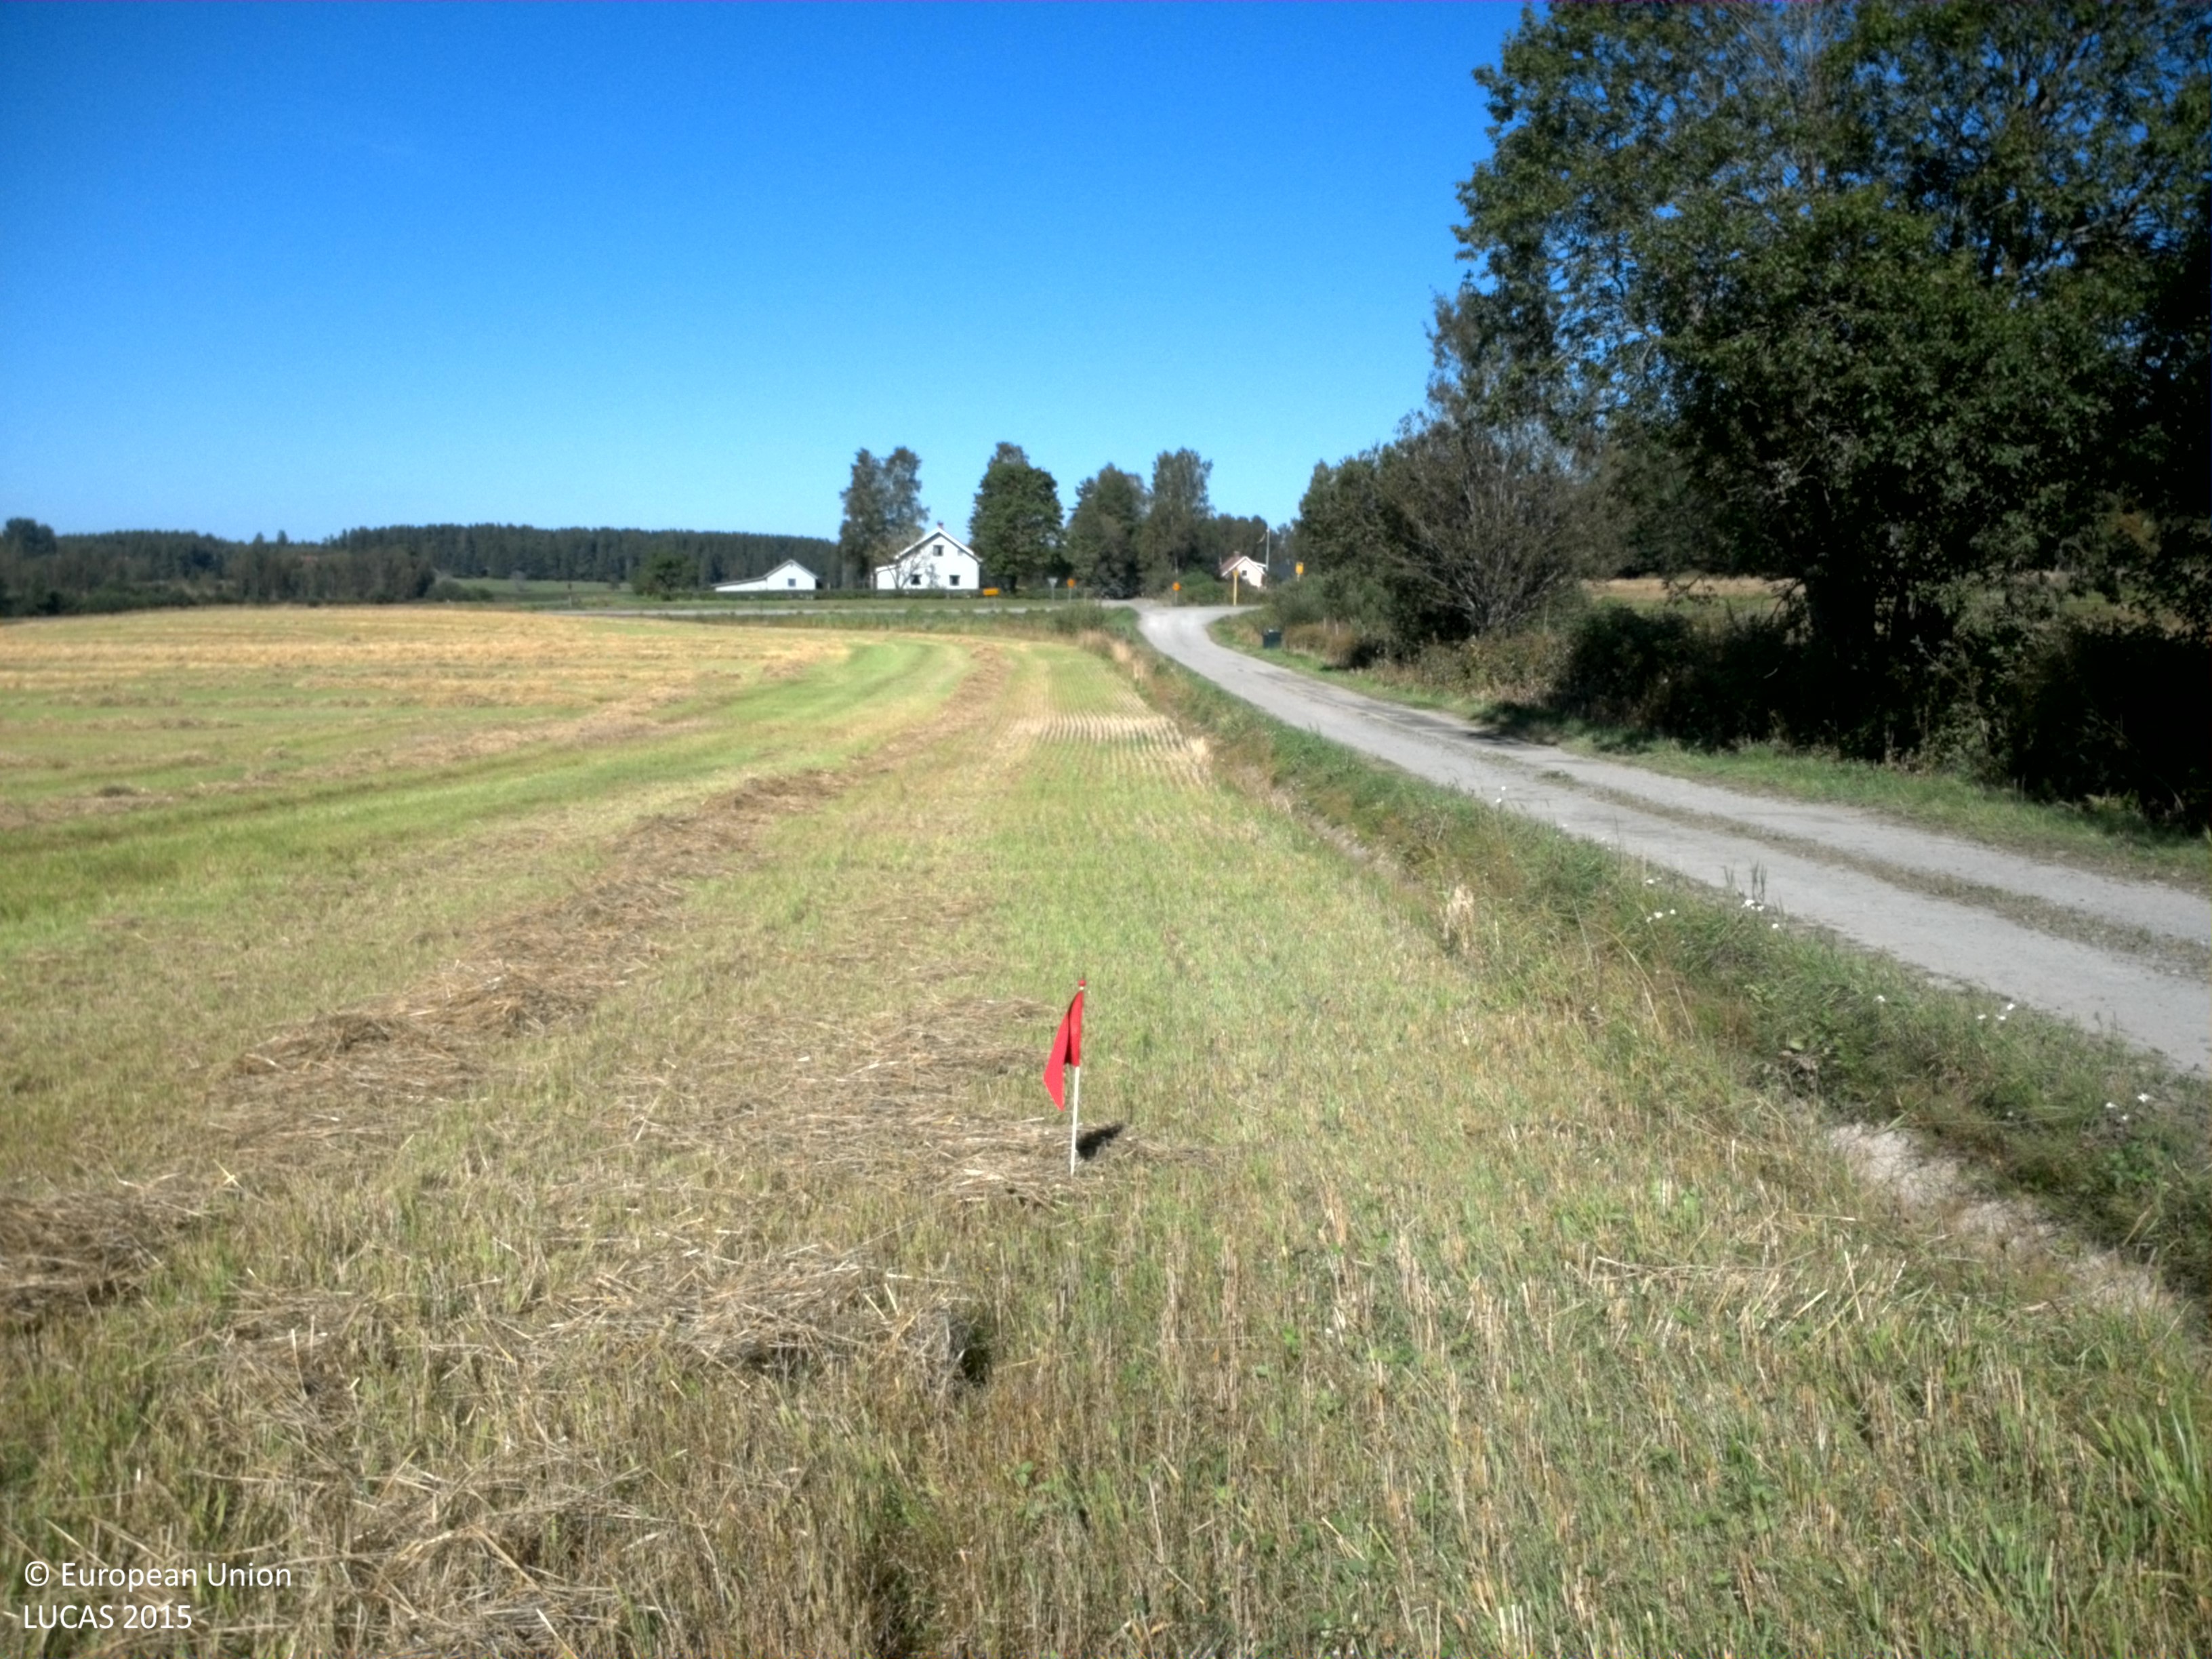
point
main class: Cropland
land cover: Other leguminous and mixtures for fodder
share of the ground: > 75 %
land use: Agriculture (excluding fallow land and kitchen gardens)
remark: Harvested field
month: August
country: SE
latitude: 59.4013
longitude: 13.3915
